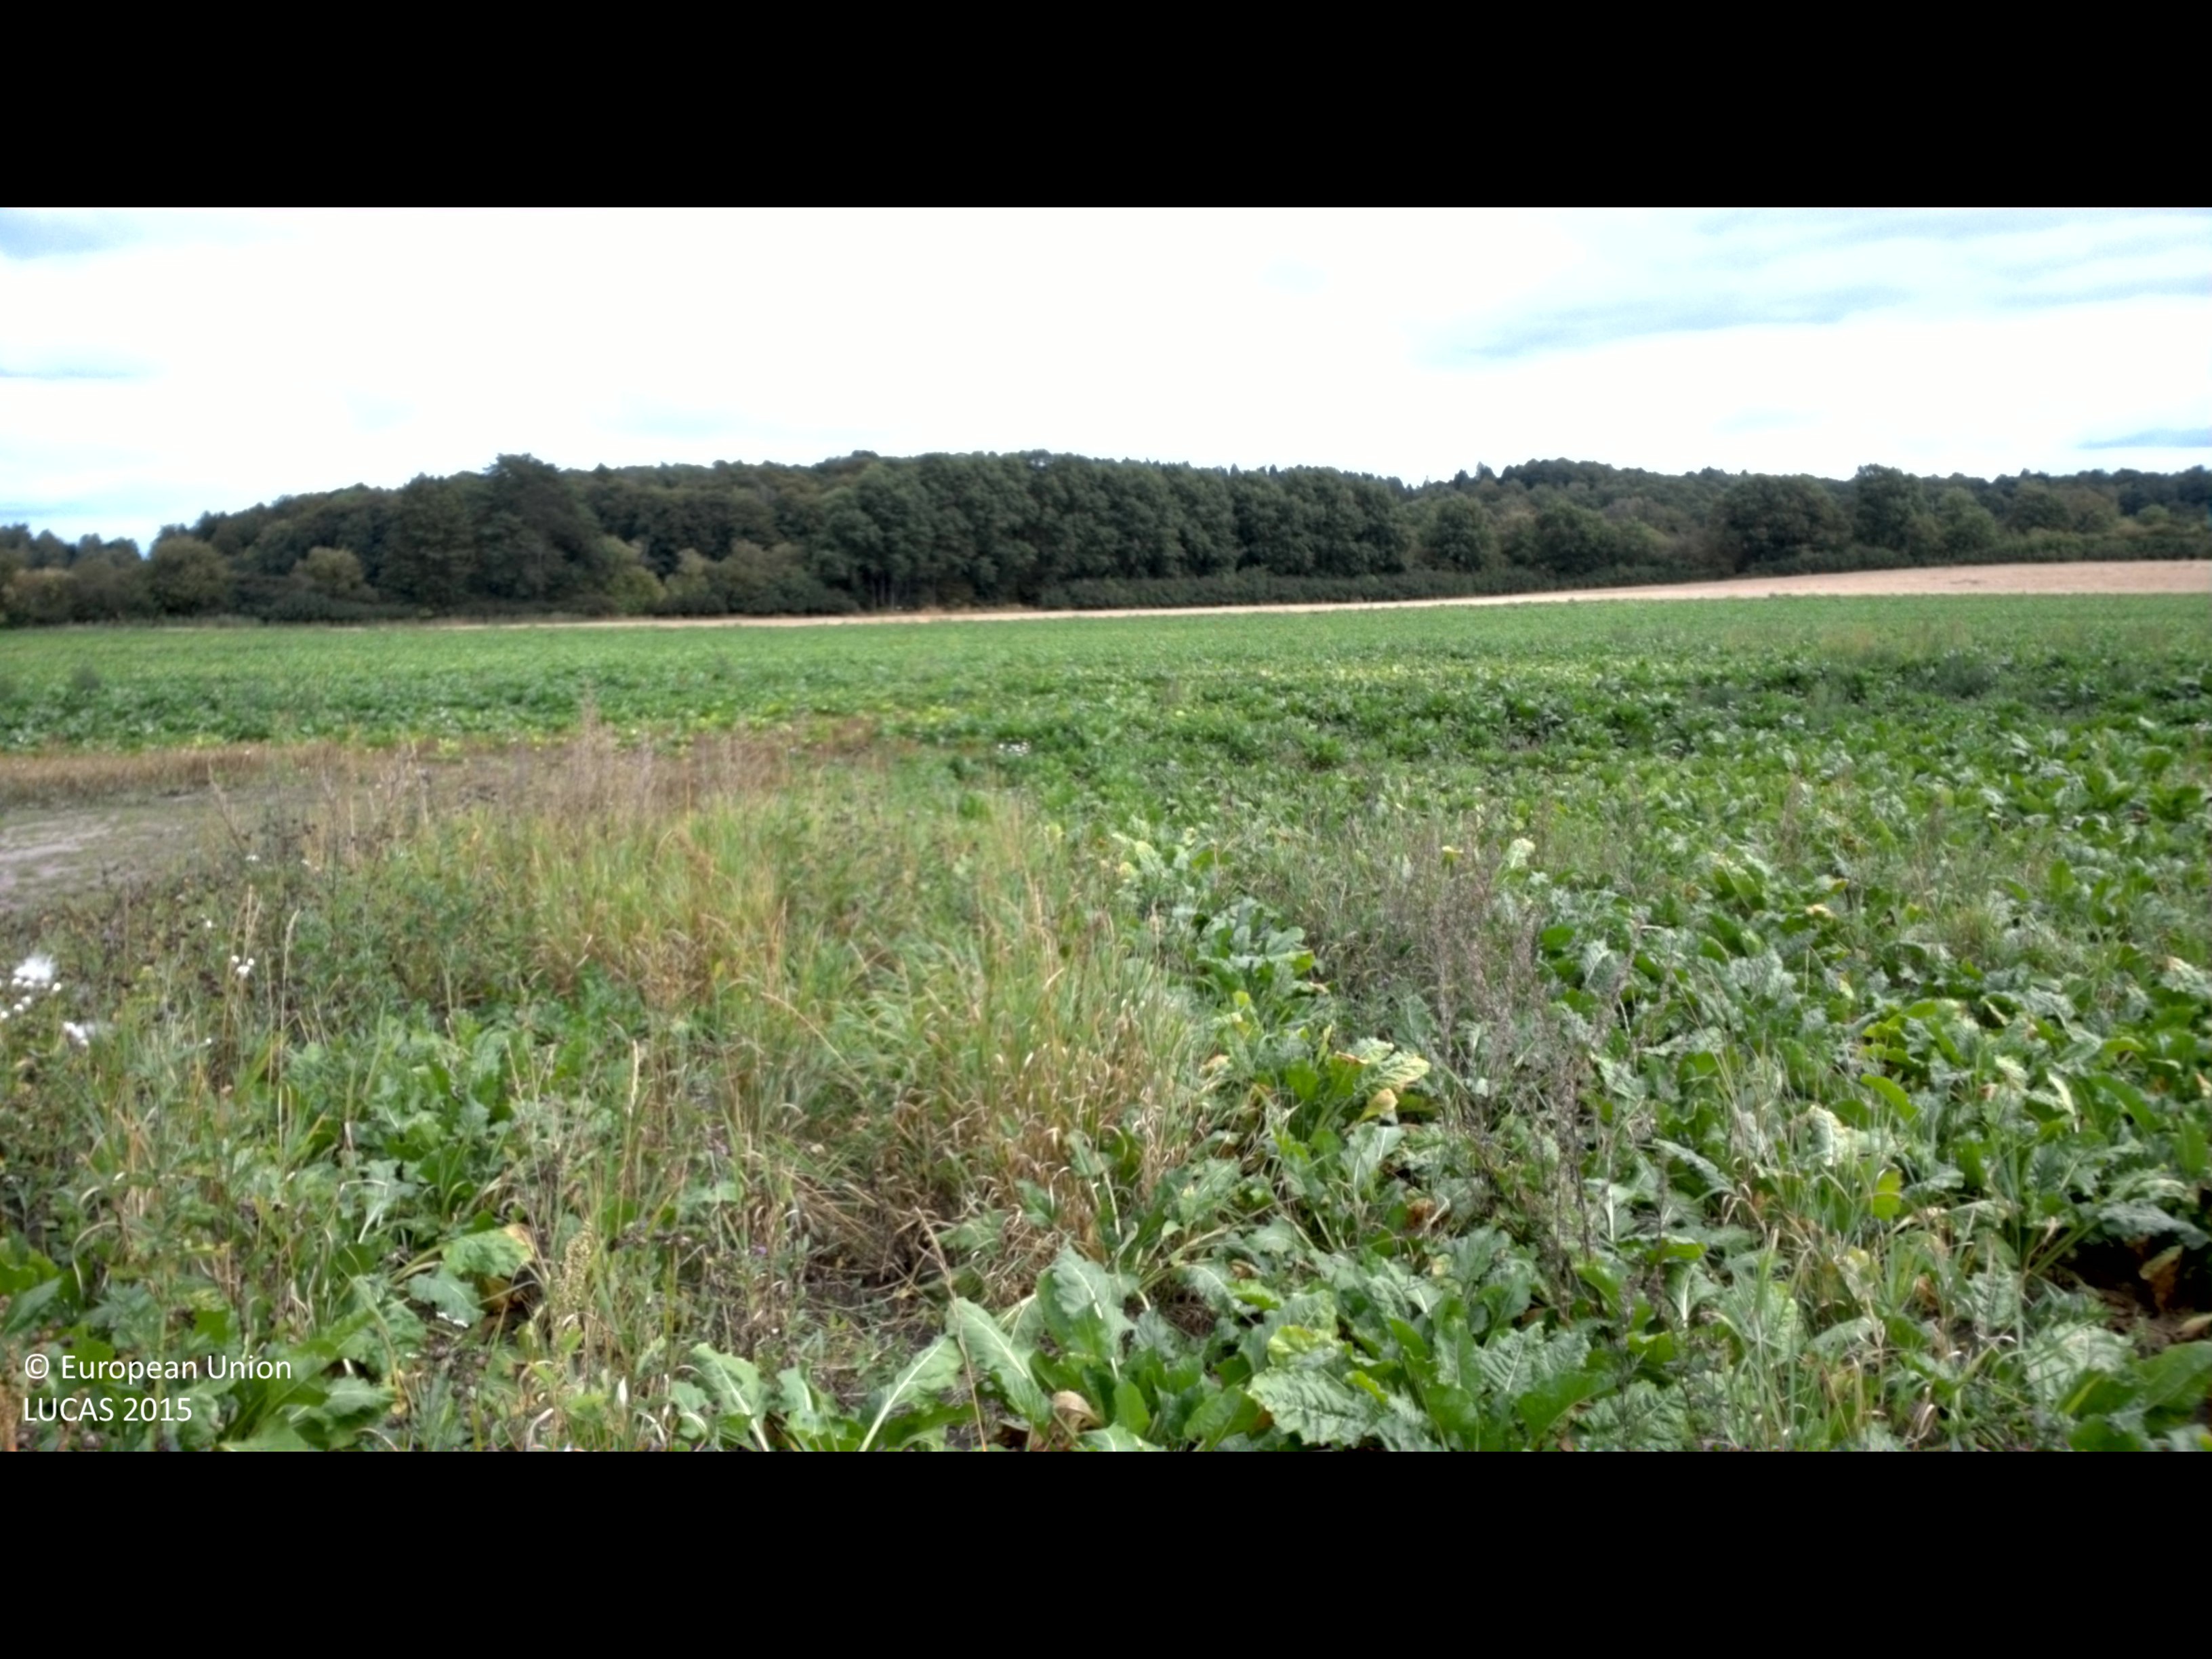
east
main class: Cropland
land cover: Sugar beet
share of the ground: > 75 %
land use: Agriculture (excluding fallow land and kitchen gardens)
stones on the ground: < 10 %
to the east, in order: Sugar beet; Barley; Abandoned hedges; Grassland without tree/shrub cover
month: September
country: SE
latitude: 56.0780
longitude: 14.3522
